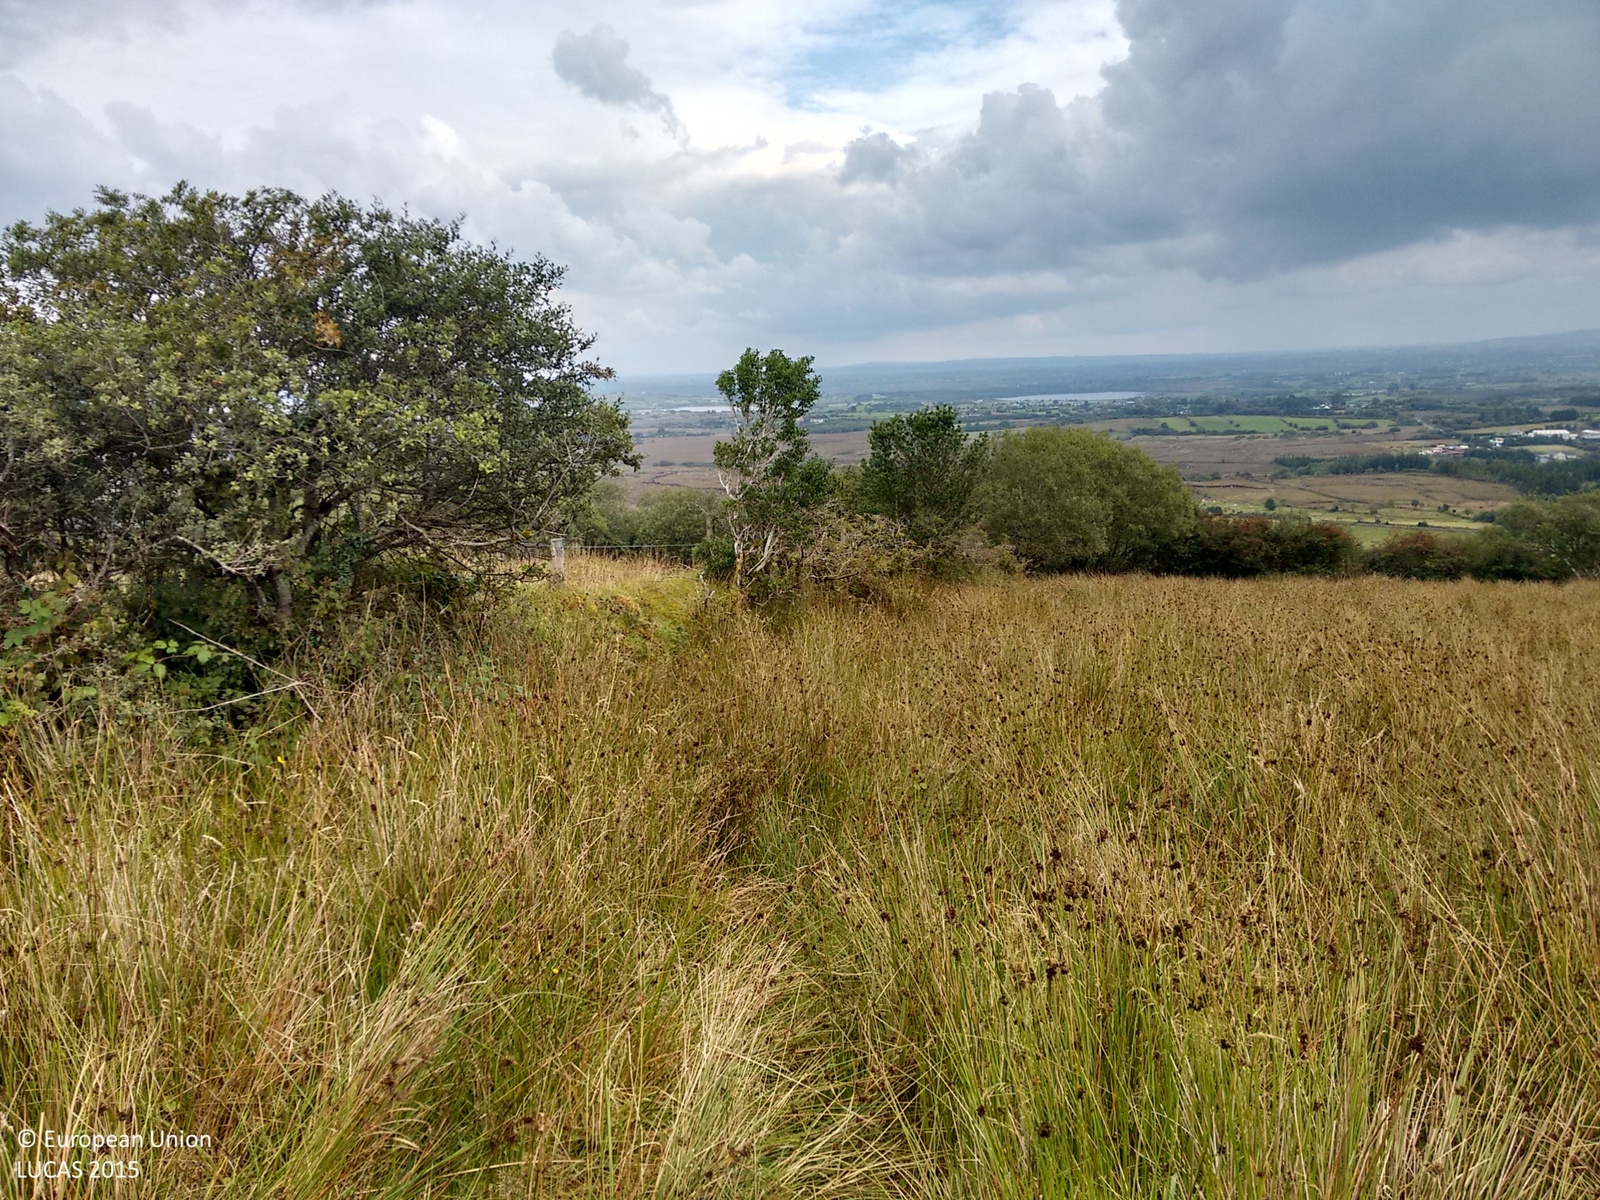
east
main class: Grassland
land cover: Grassland with sparse tree/shrub cover
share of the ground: > 75 %
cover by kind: herbaceous plants 85 %, shrubs 10 %, broadleaved forest trees 5 %
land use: Agriculture (excluding fallow land and kitchen gardens)
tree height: < 5 m
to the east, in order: Grassland with sparse tree/shrub cover; Abandoned hedges; Fences; Grassland without tree/shrub cover; Fences; Broadleaved woodland; Tracks; Ditches and canals; Broadleaved woodland; Fences; Grassland without tree/shrub cover; Fences; Ditches and canals; Broadleaved woodland; Dry stone walls; Abandoned hedges; Fences; Grassland without tree/shrub cover
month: September
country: IE
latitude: 53.9250
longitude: -9.2731
